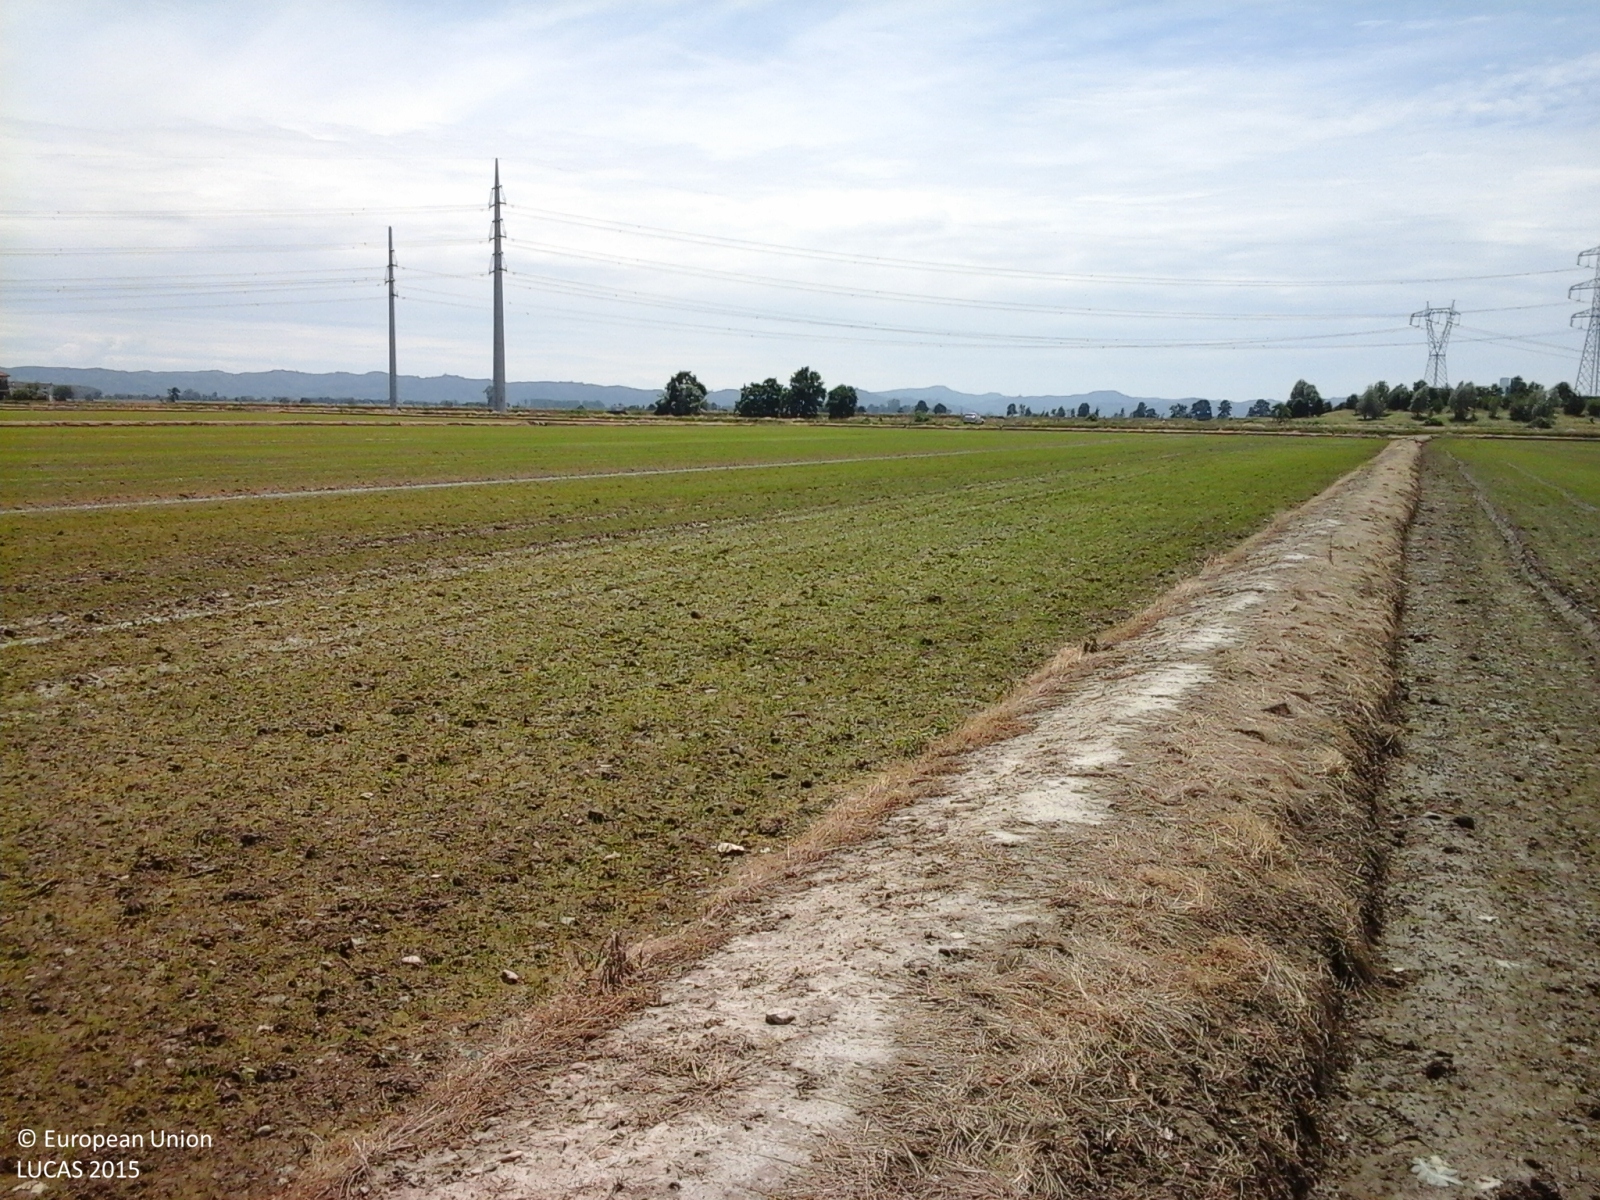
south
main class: Cropland
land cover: Rice
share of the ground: < 10 %
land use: Agriculture (excluding fallow land and kitchen gardens)
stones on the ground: < 10 %
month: May
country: IT
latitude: 45.2548
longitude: 8.2064
